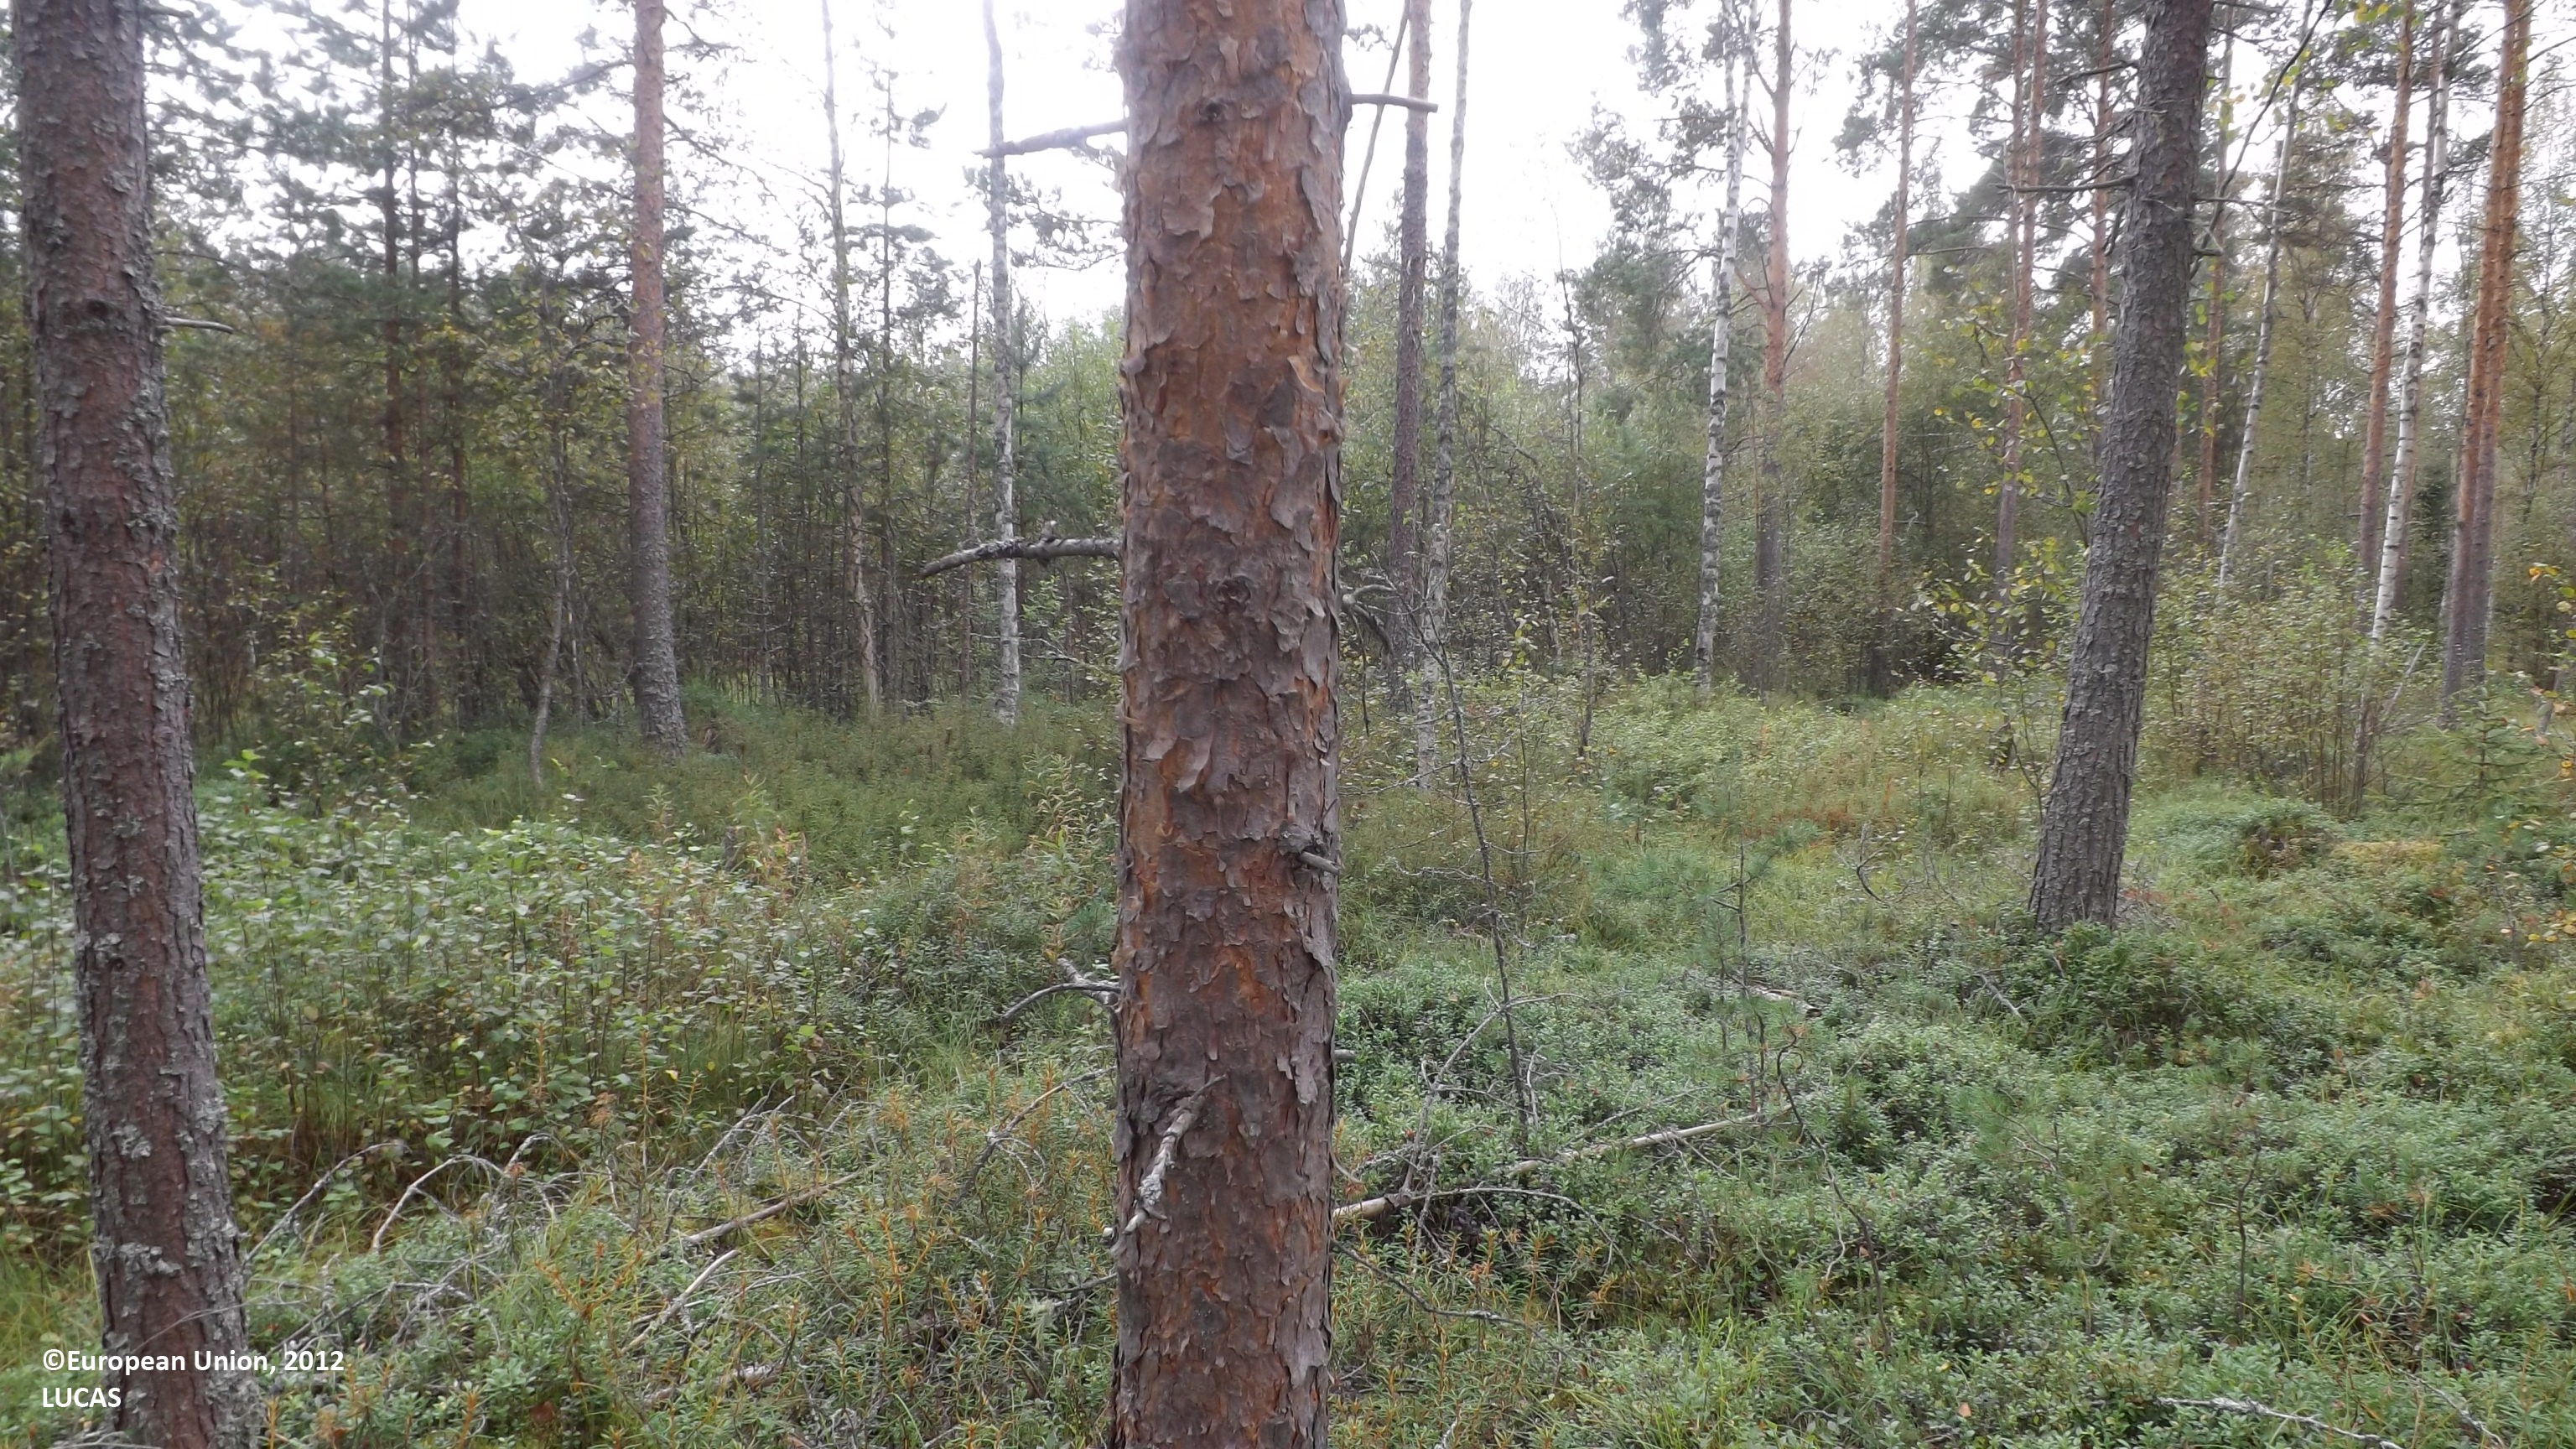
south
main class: Woodland
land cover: Pine dominated mixed woodland
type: boreal forest
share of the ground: 50 - 75 %
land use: Forestry
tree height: > 5 m
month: August
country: FI
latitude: 63.9005
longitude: 23.8153
